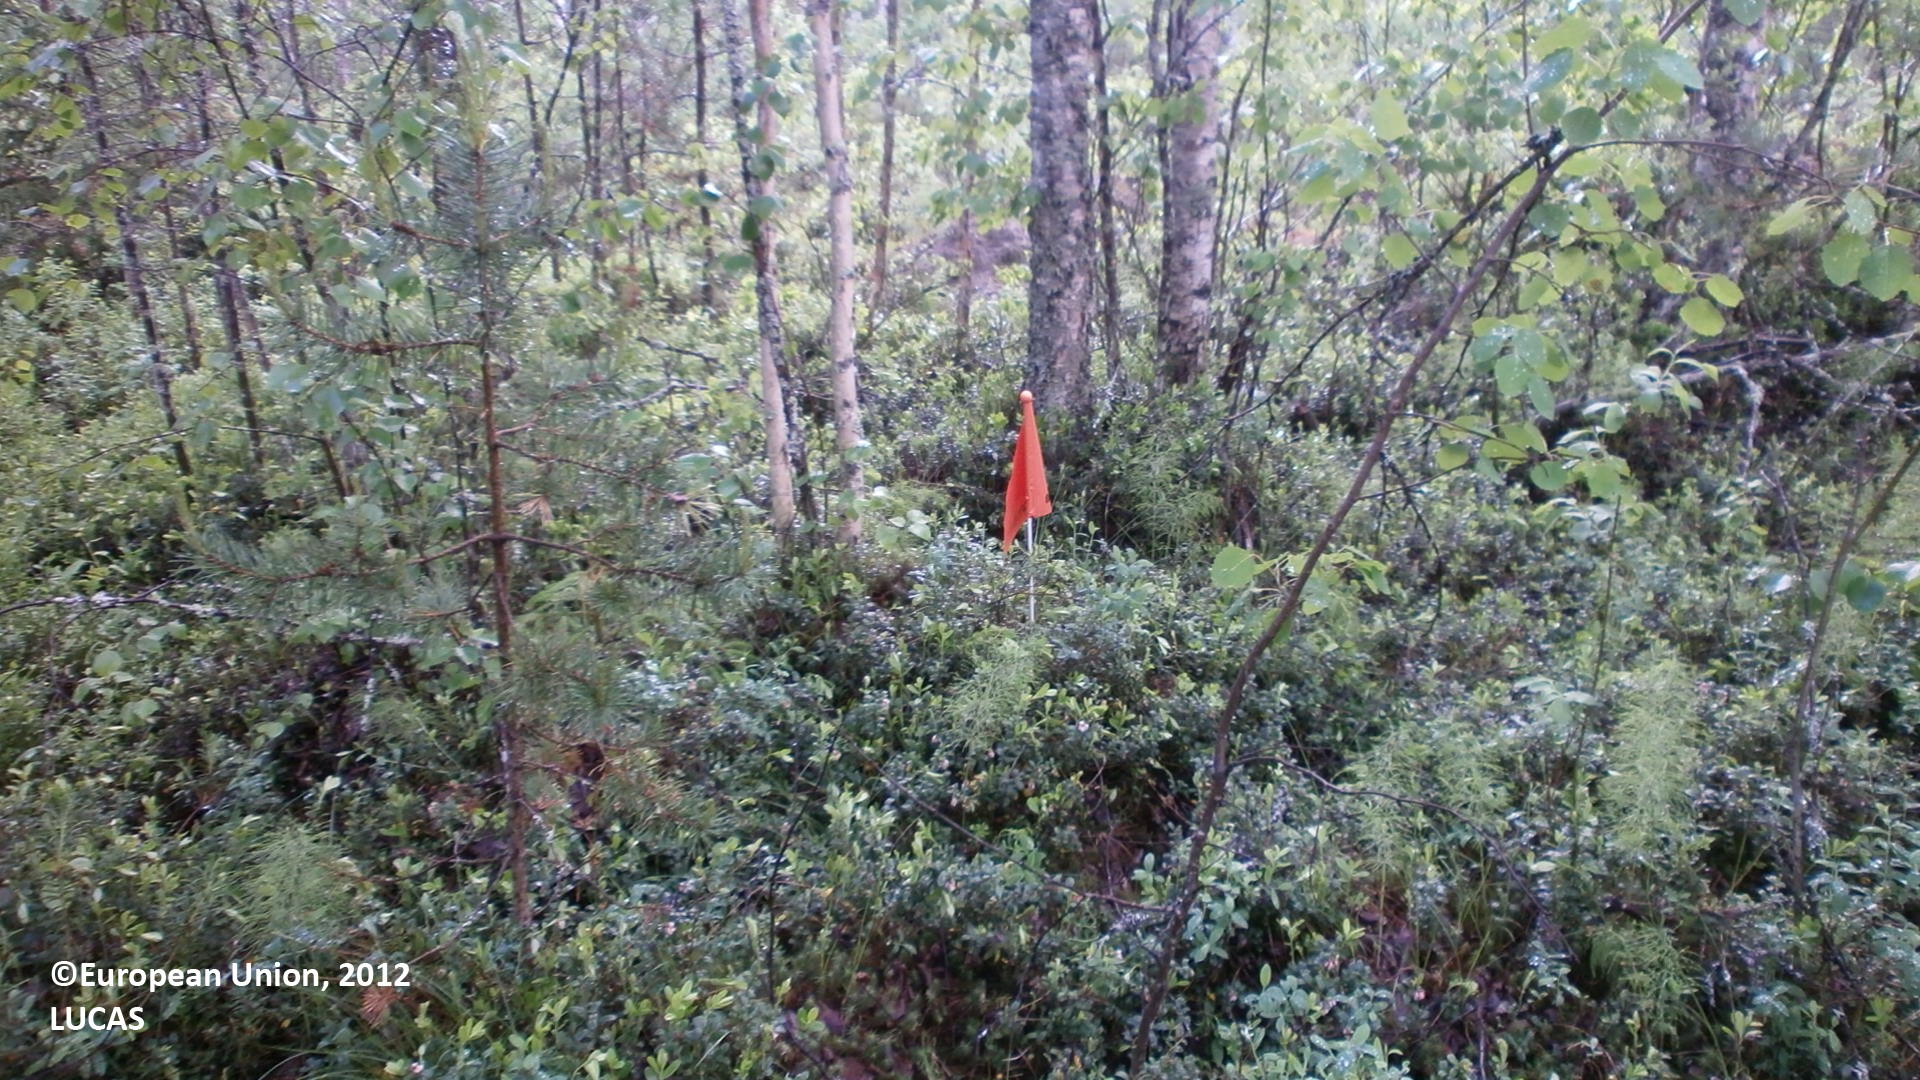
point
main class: Woodland
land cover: Broadleaved woodland
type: boreal forest
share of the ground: > 75 %
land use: Forestry
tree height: > 5 m
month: June
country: FI
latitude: 64.7861
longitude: 25.2068
